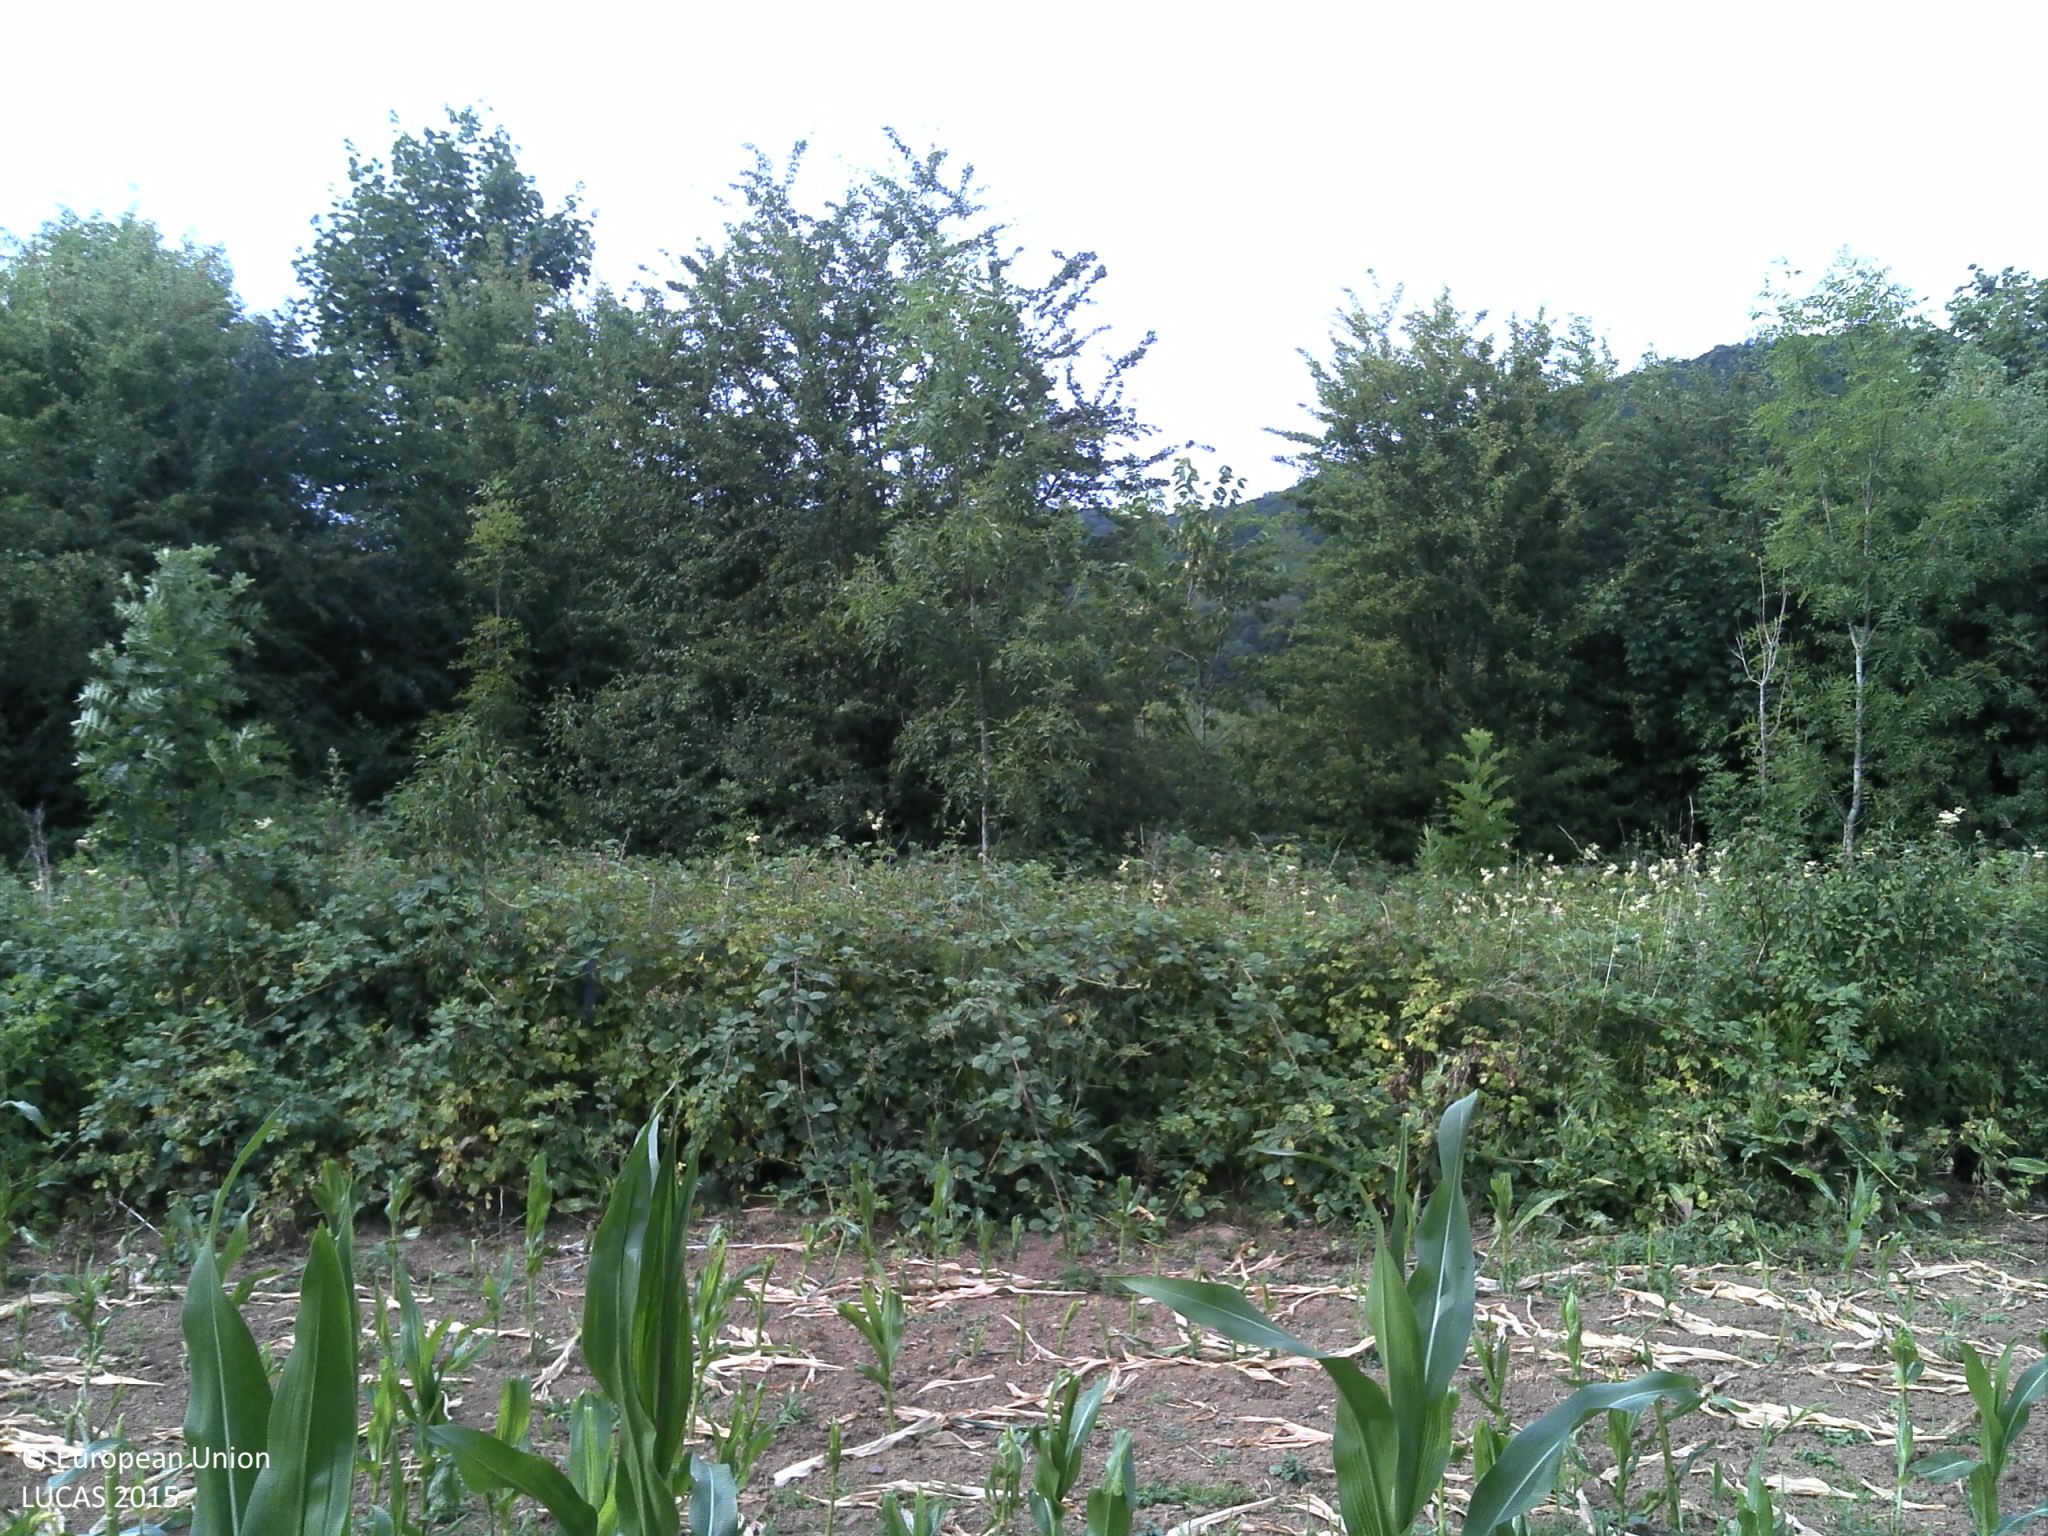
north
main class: Cropland
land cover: Maize
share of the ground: 50 - 75 %
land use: Agriculture (excluding fallow land and kitchen gardens)
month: July
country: FR
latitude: 49.7935
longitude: 4.7597
